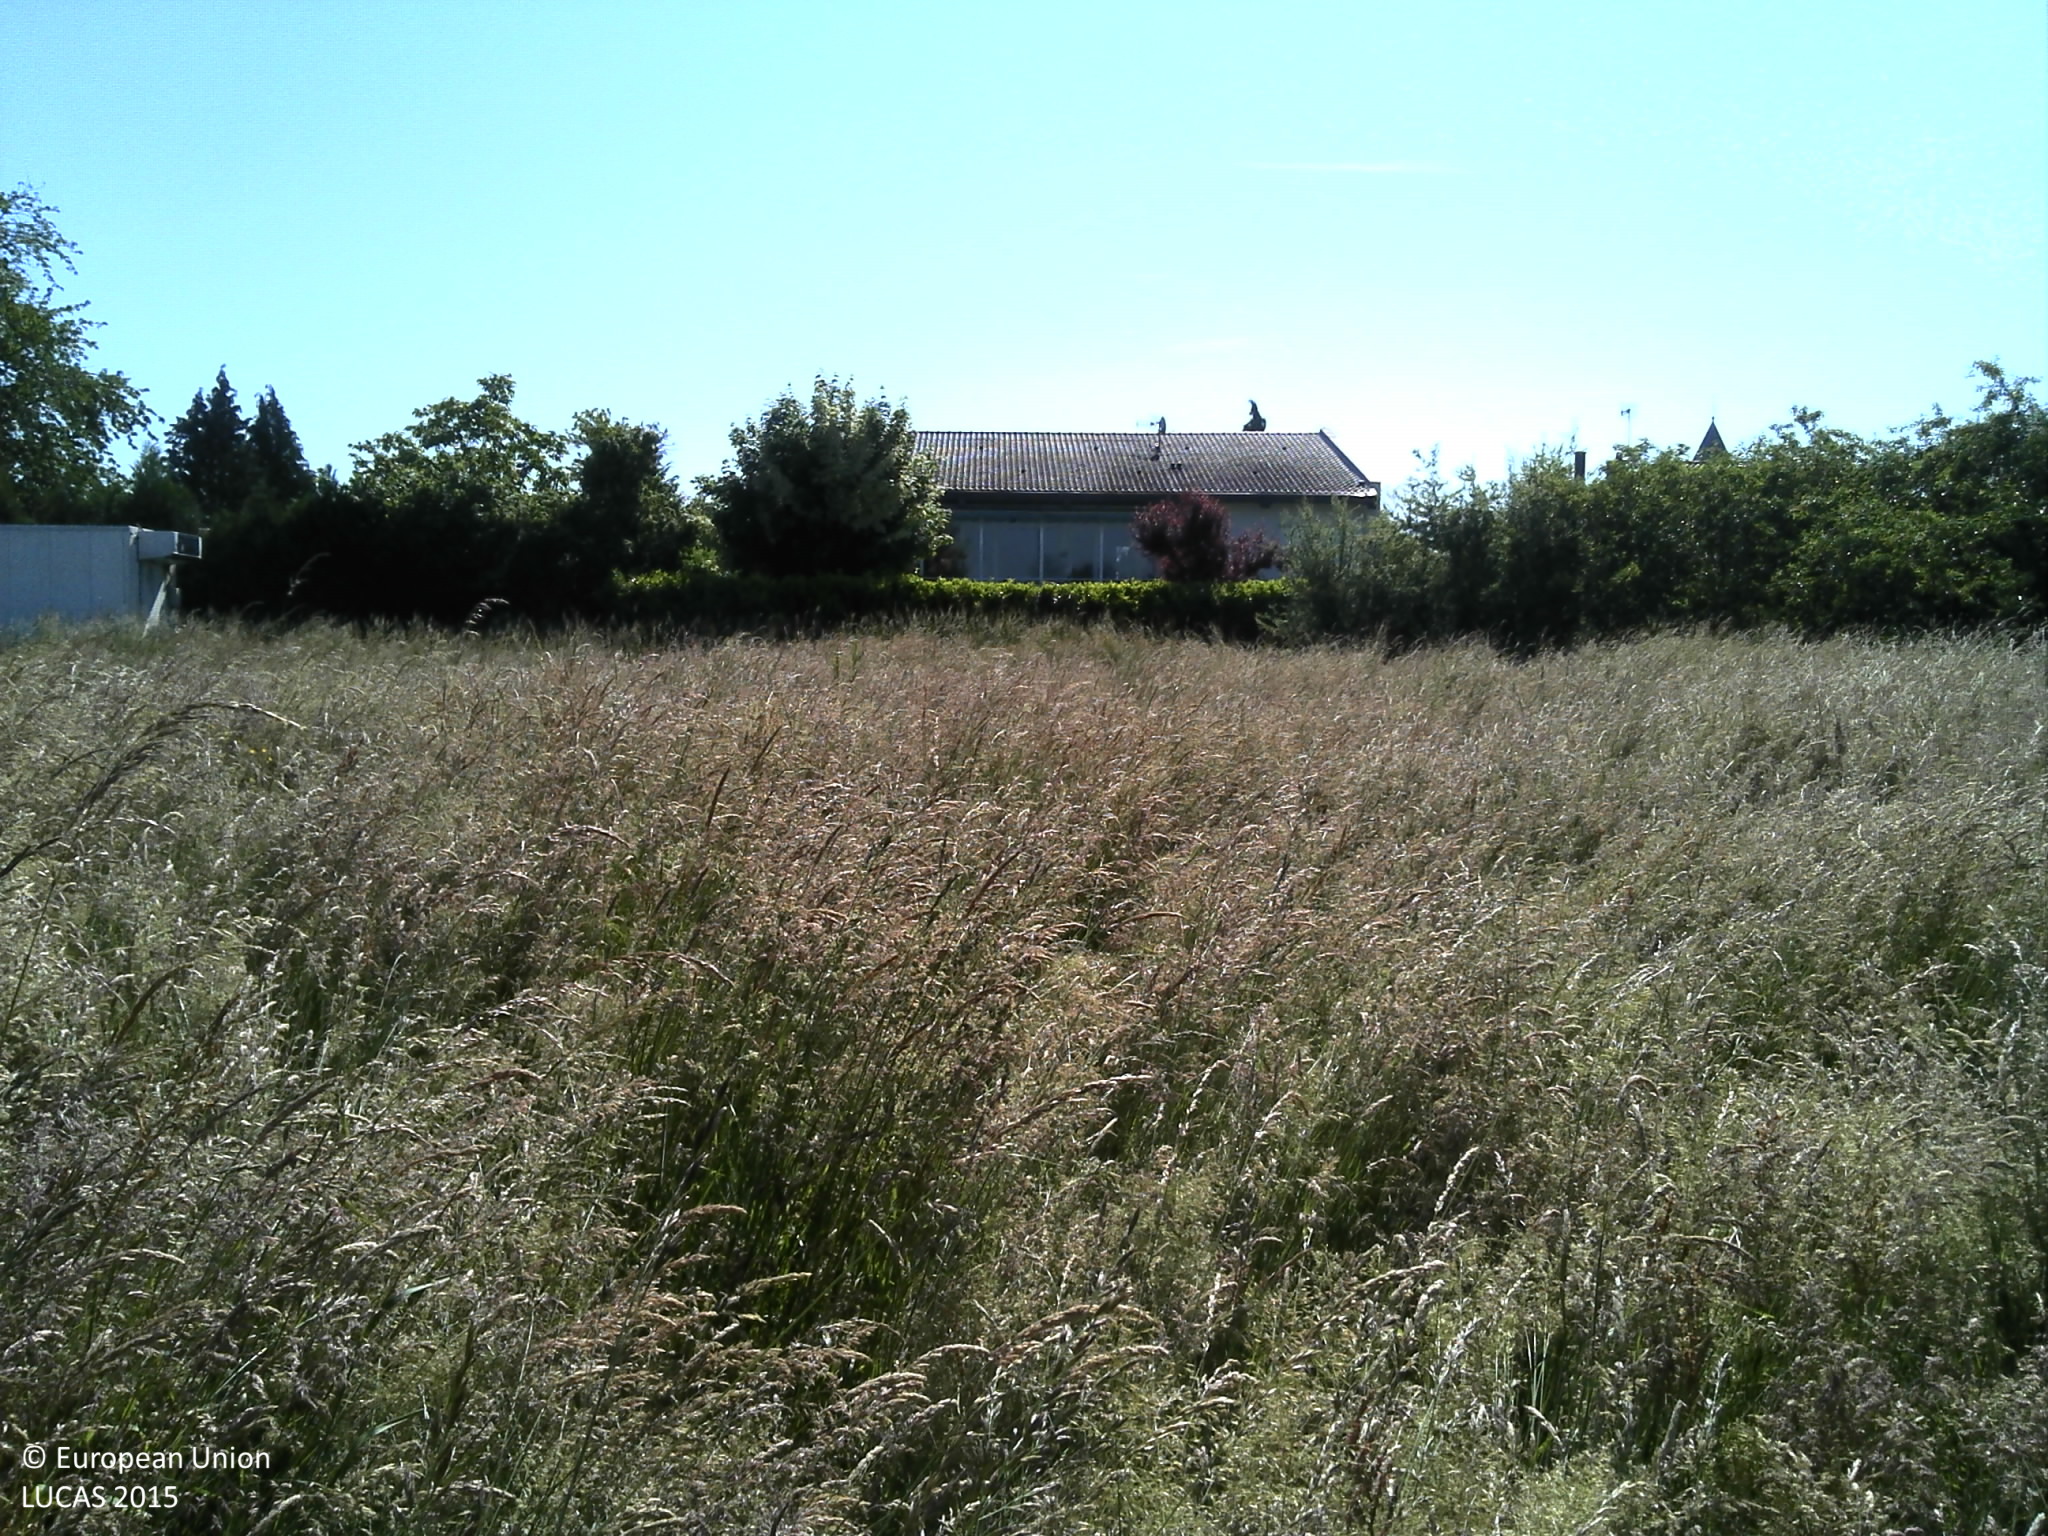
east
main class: Grassland
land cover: Grassland without tree/shrub cover
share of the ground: > 75 %
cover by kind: herbaceous plants 100 %
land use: Agriculture (excluding fallow land and kitchen gardens)
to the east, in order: Grassland without tree/shrub cover; Artificial constructions in urban areas
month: June
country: FR
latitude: 48.9484
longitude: 6.1355
